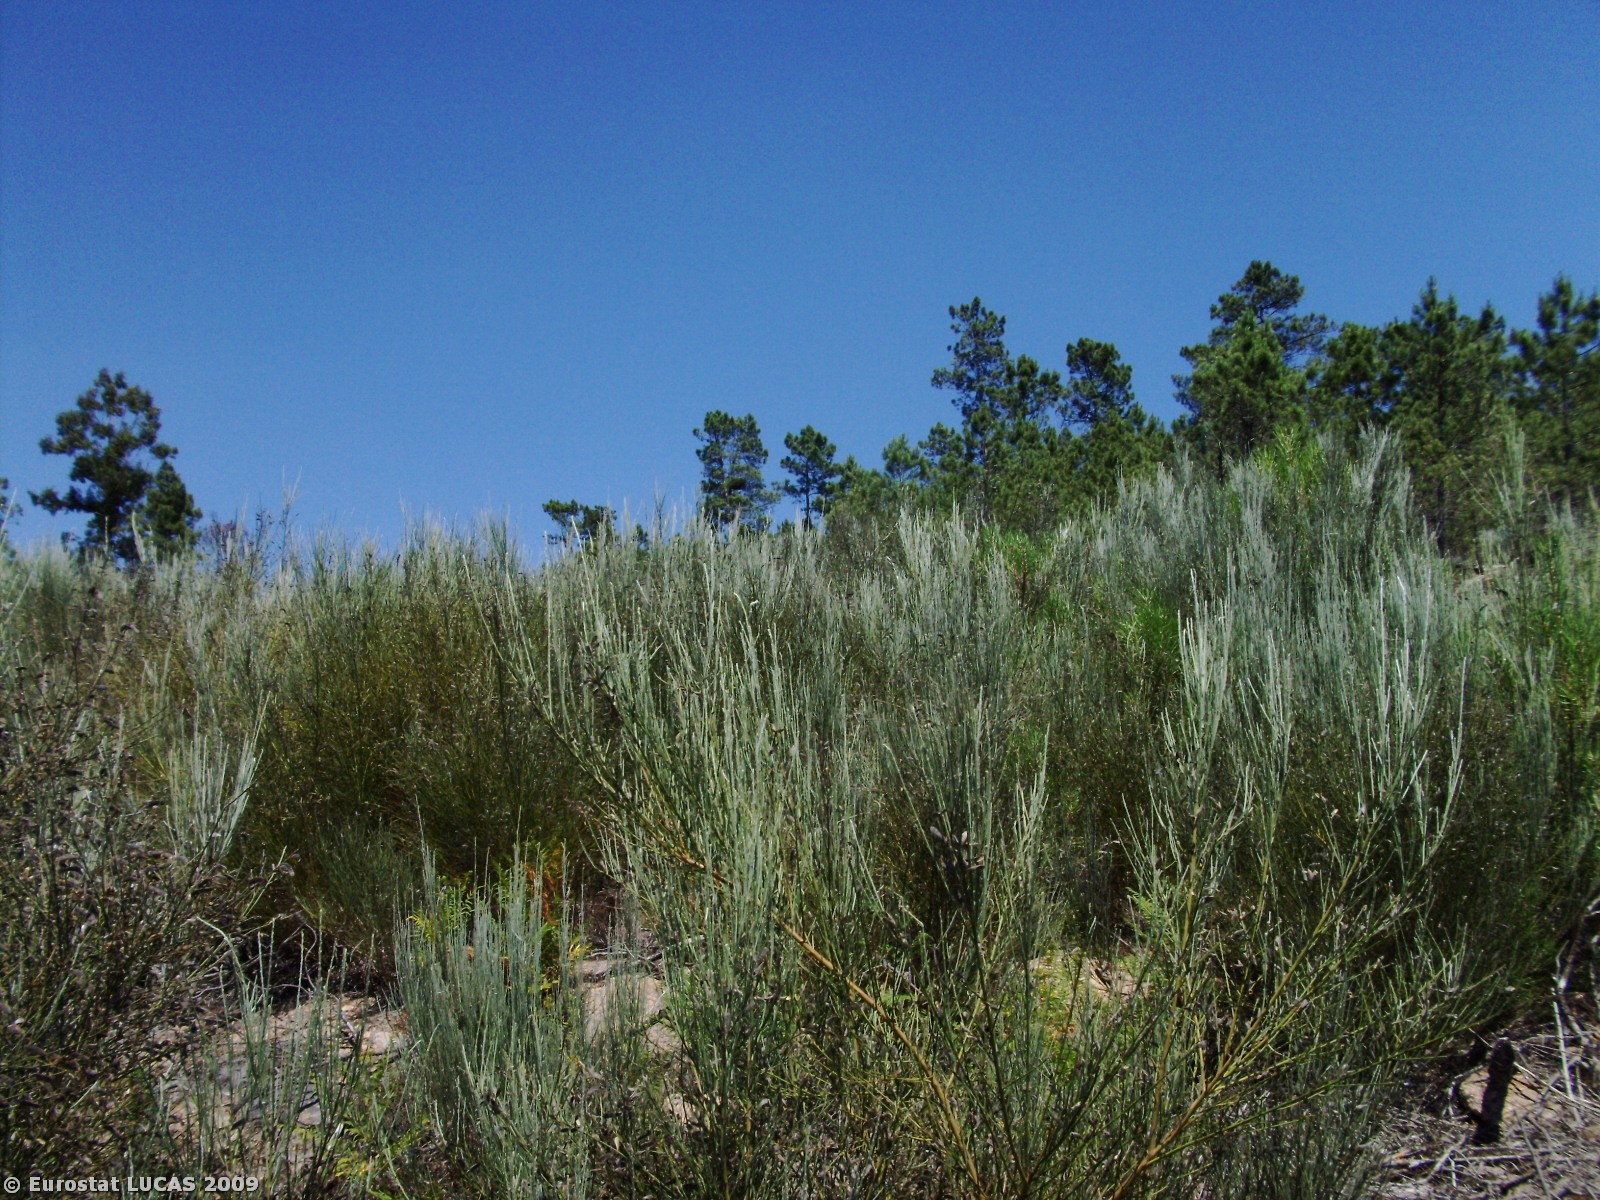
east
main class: Shrubland
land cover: Shrubland without tree cover
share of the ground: 50 - 75 %
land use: Unused
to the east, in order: Shrubland without tree cover; Coniferous woodland; Shrubland with sparse tree cover; Coniferous woodland; Tracks; Coniferous woodland; Rock outcrops; Coniferous woodland; Rock outcrops; Coniferous woodland; Rock outcrops; Coniferous woodland; Shrubland without tree cover; Rock outcrops; Shrubland without tree cover; Rock outcrops
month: July
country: PT
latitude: 40.6851
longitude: -7.6414
